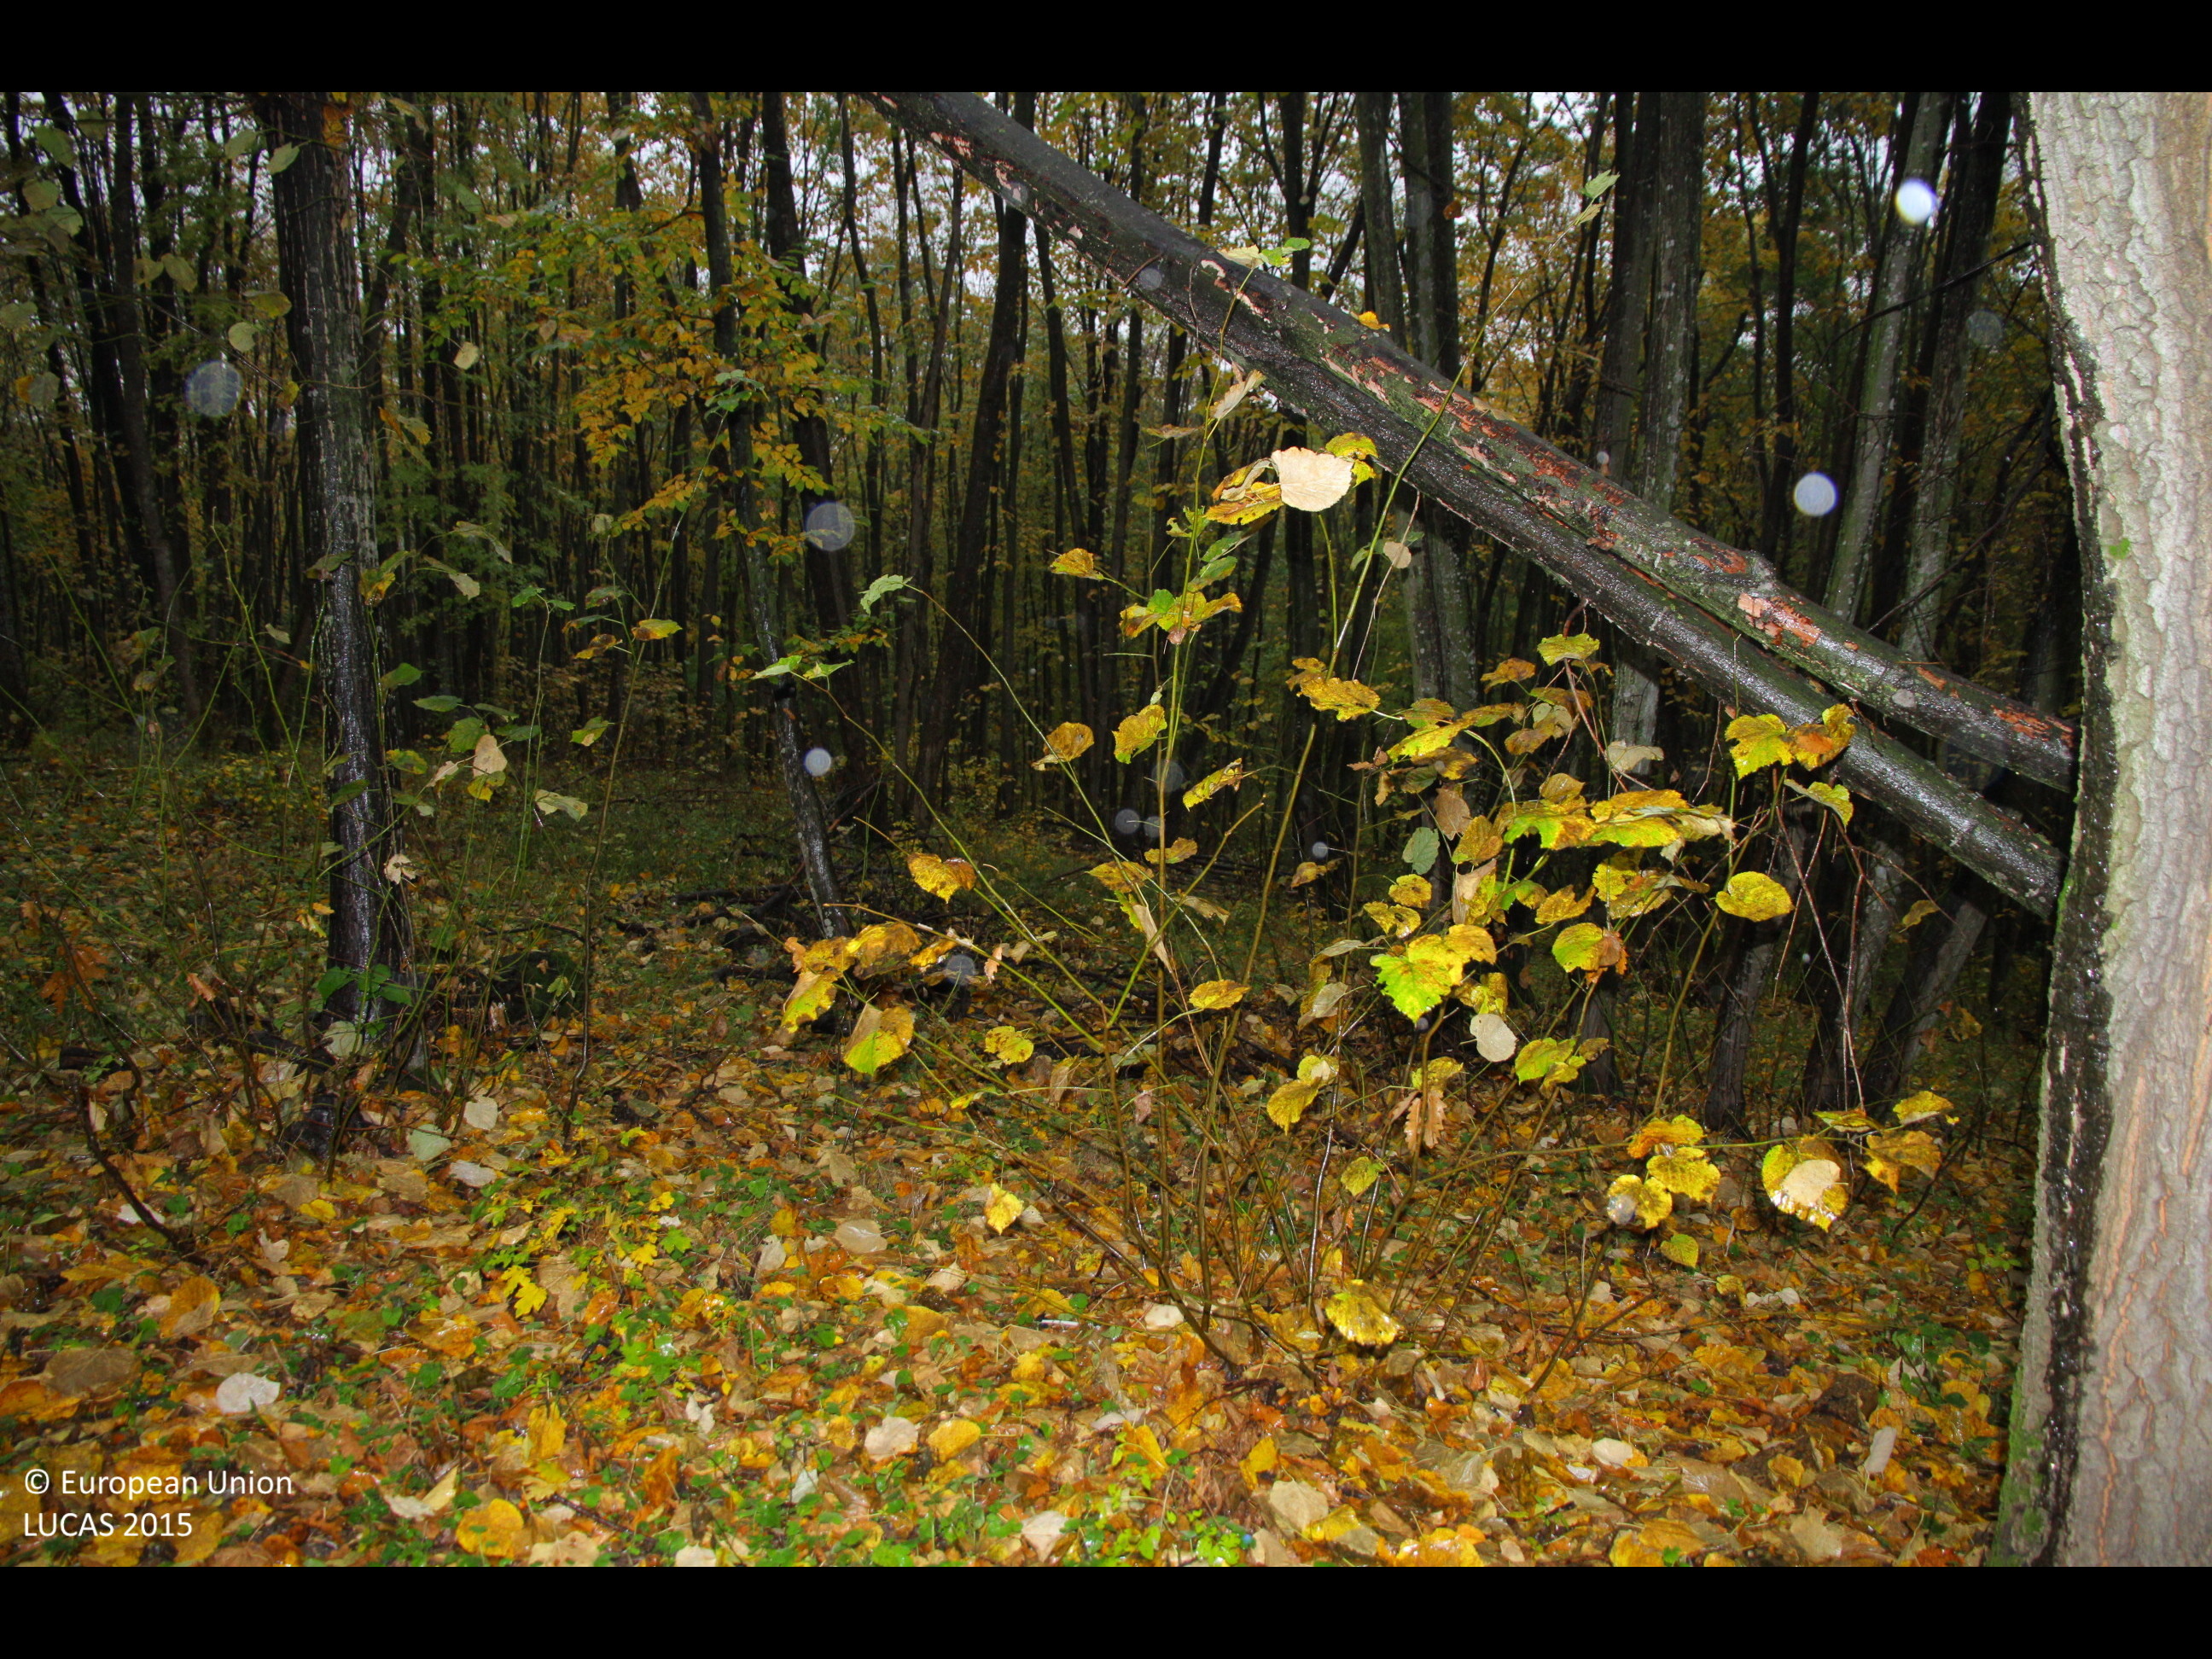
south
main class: Woodland
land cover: Broadleaved woodland
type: beech forest
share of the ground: > 75 %
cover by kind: broadleaved forest trees 100 %
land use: Forestry
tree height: > 5 m
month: October
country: BG
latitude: 43.7595
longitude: 26.4650
